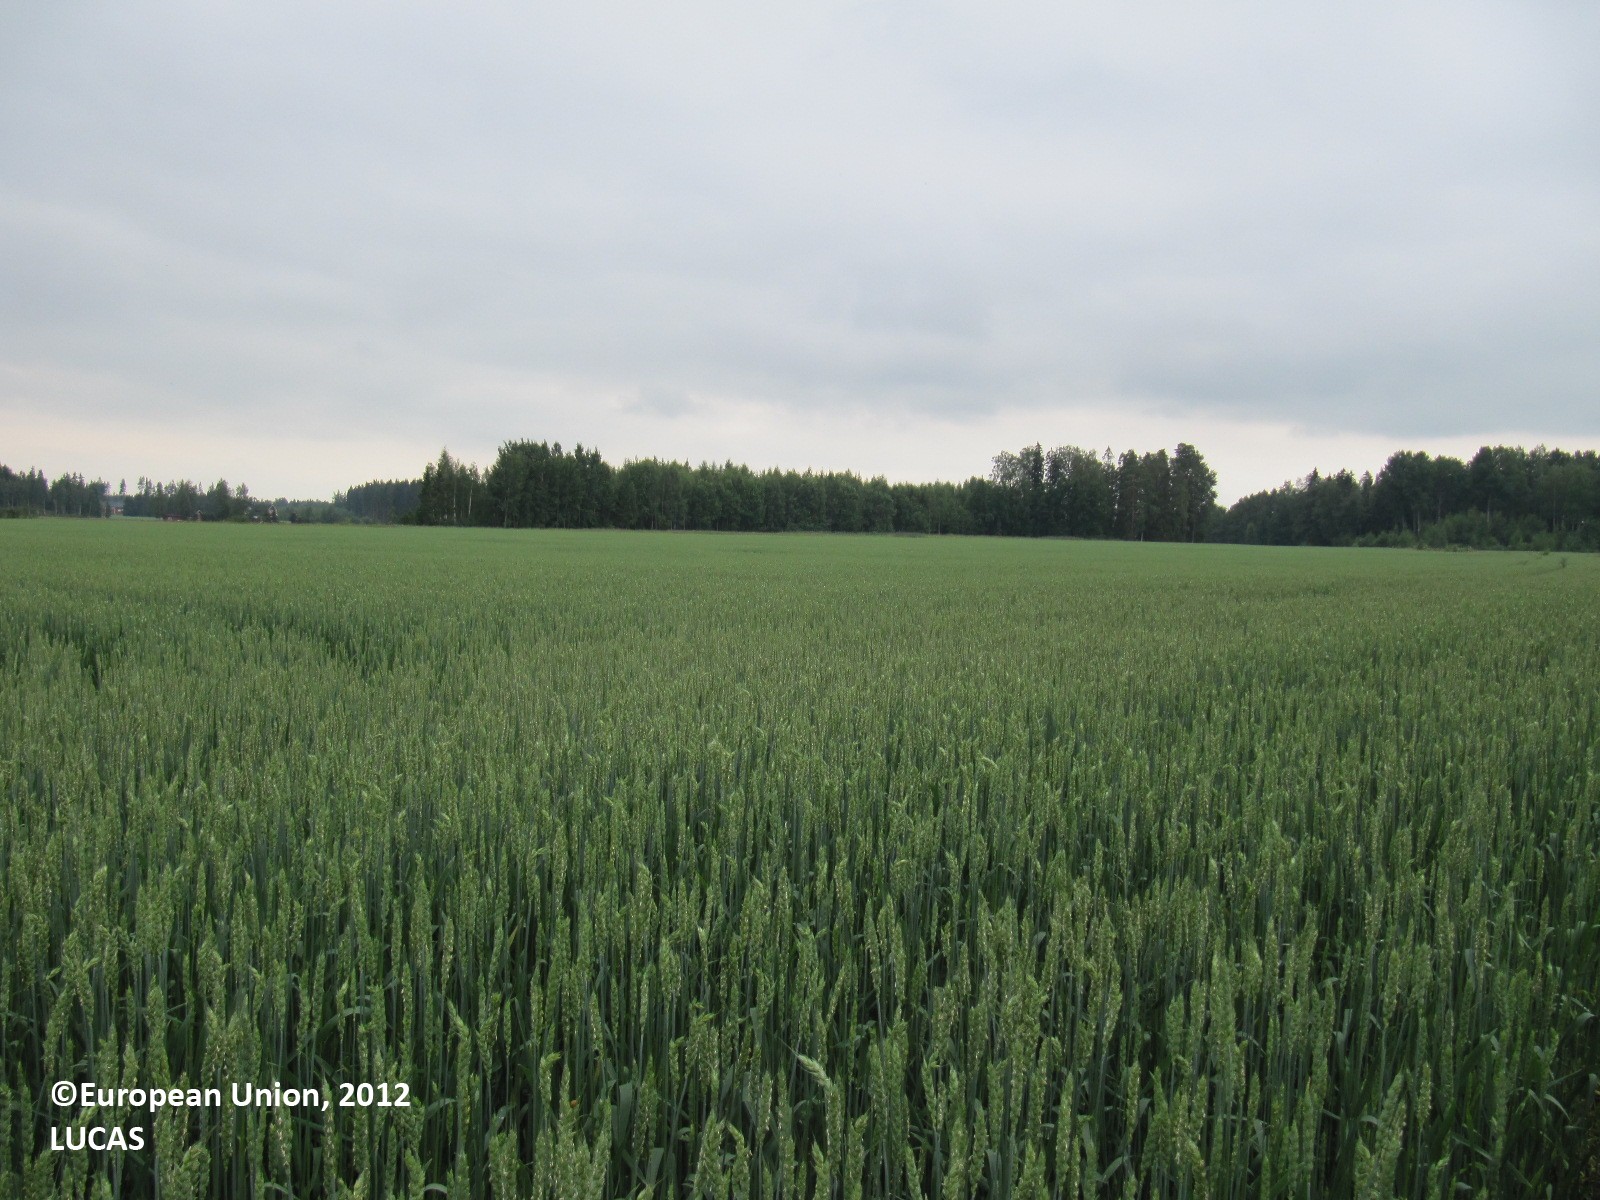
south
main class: Cropland
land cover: Common wheat
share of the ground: > 75 %
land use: Agriculture (excluding fallow land and kitchen gardens)
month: July
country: FI
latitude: 60.6976
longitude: 23.3255
